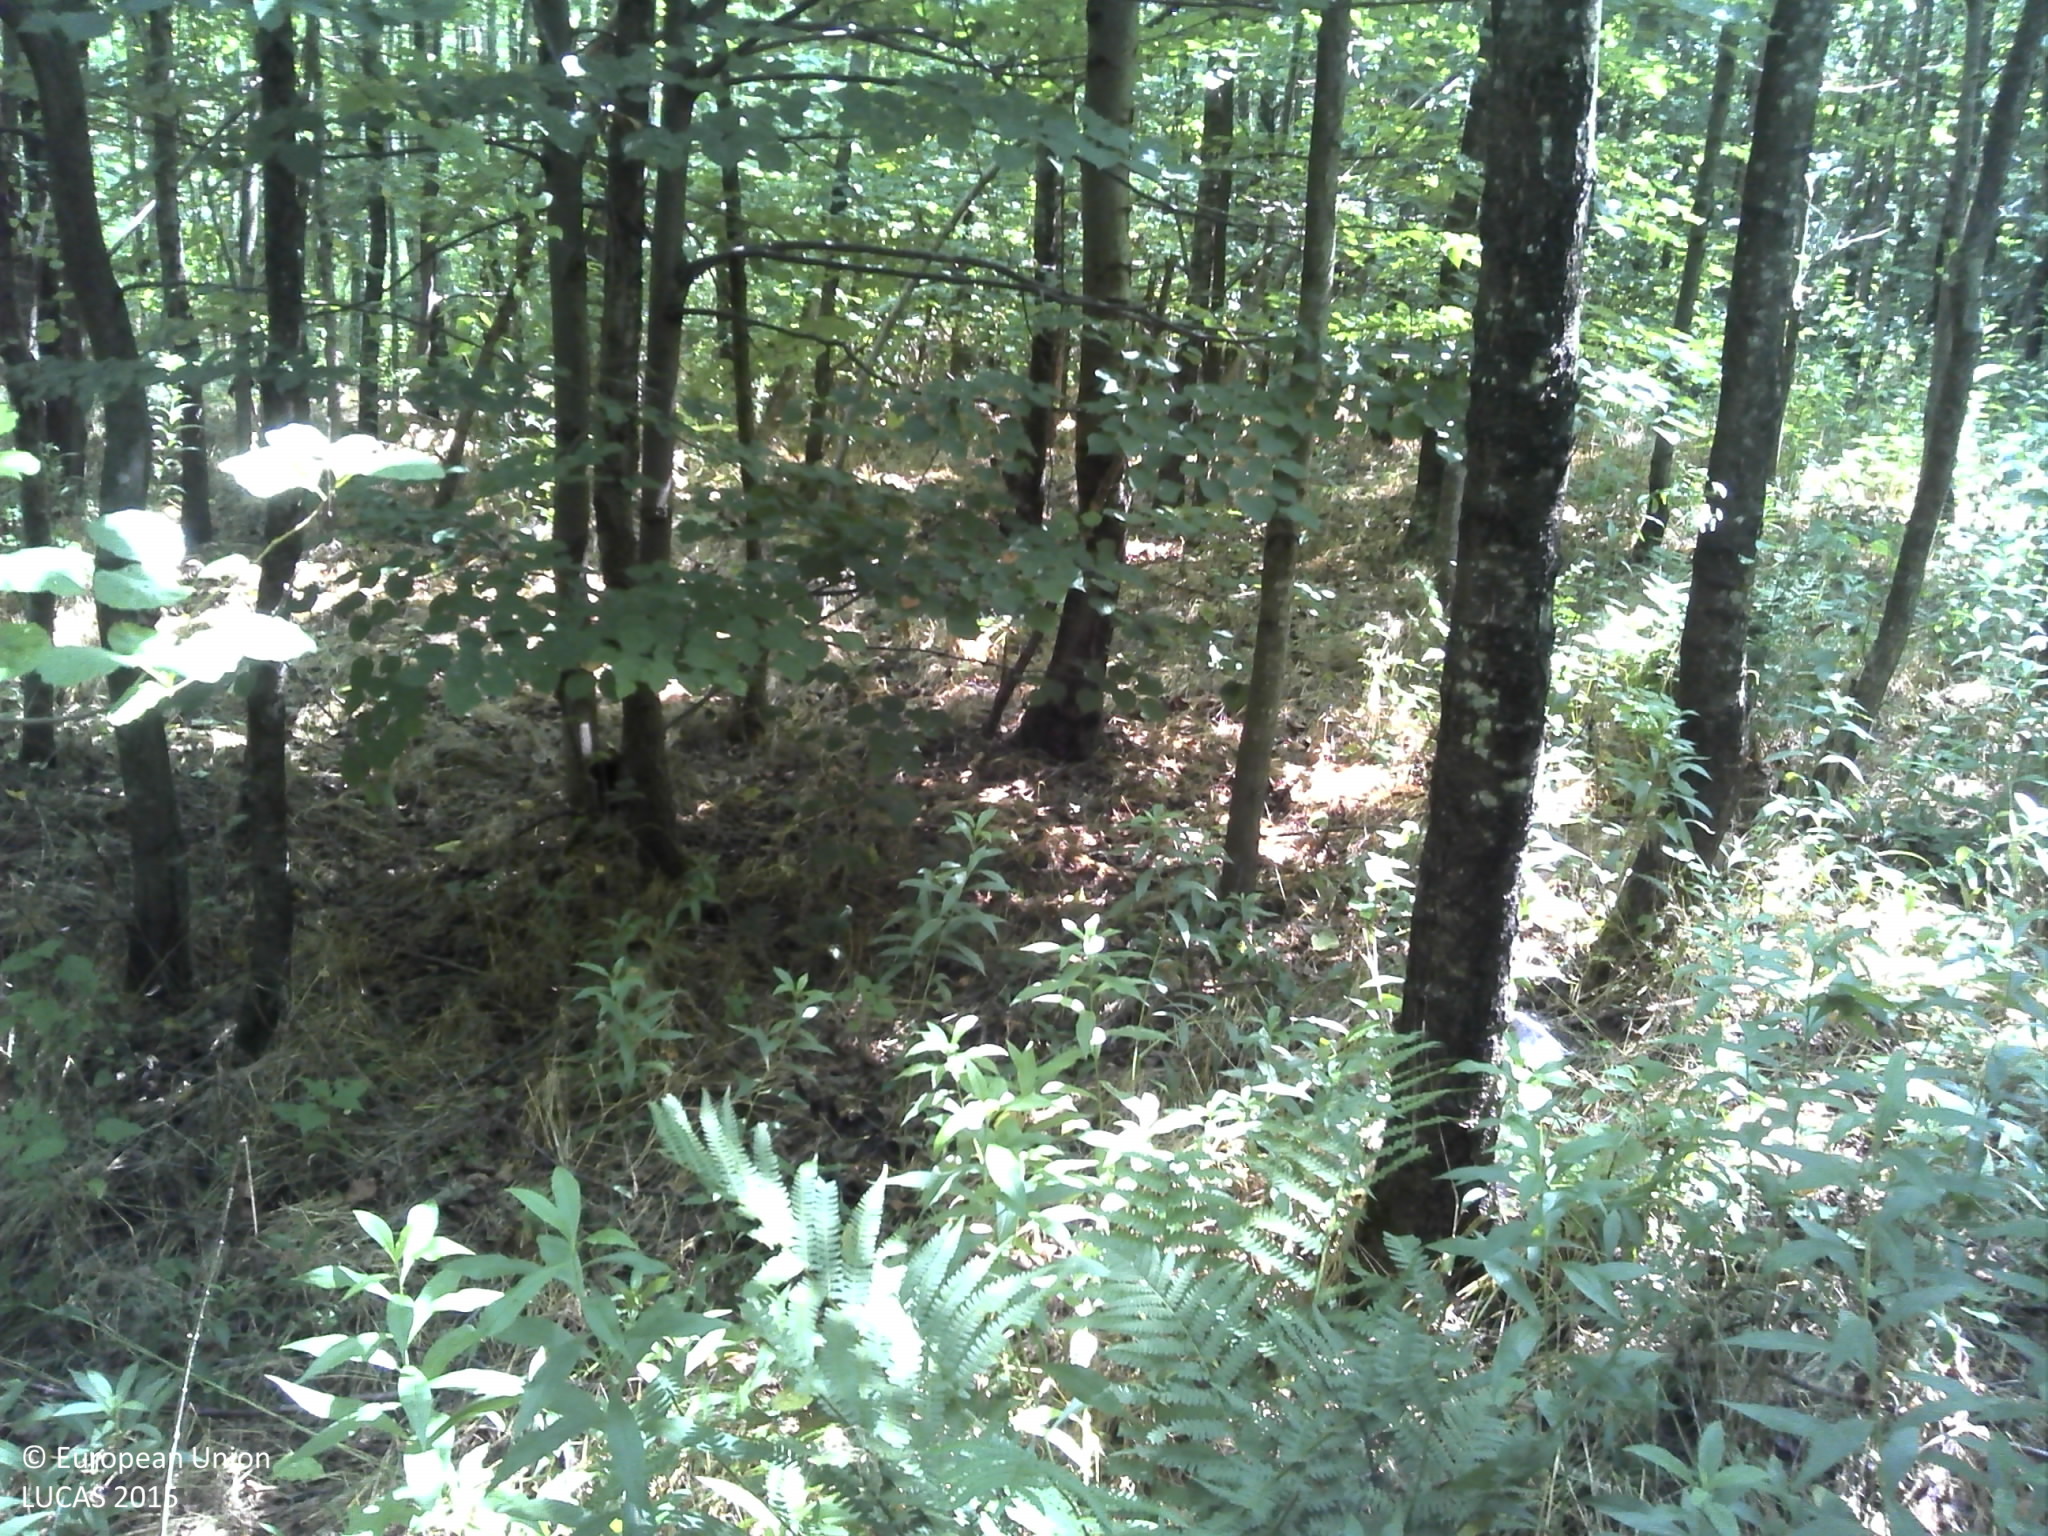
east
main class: Woodland
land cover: Broadleaved woodland
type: non-riverine alder, birch or aspen forest
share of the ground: > 75 %
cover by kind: broadleaved forest trees 90 %, shrubs 5 %, herbaceous plants 5 %
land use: Forestry
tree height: > 5 m
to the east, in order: Broadleaved woodland; Shrubland with sparse tree cover; Other bare soil; Spontaneously vegetated surfaces; Artificial constructions; Spontaneously vegetated surfaces
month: July
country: HR
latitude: 45.7681
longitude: 16.5959
